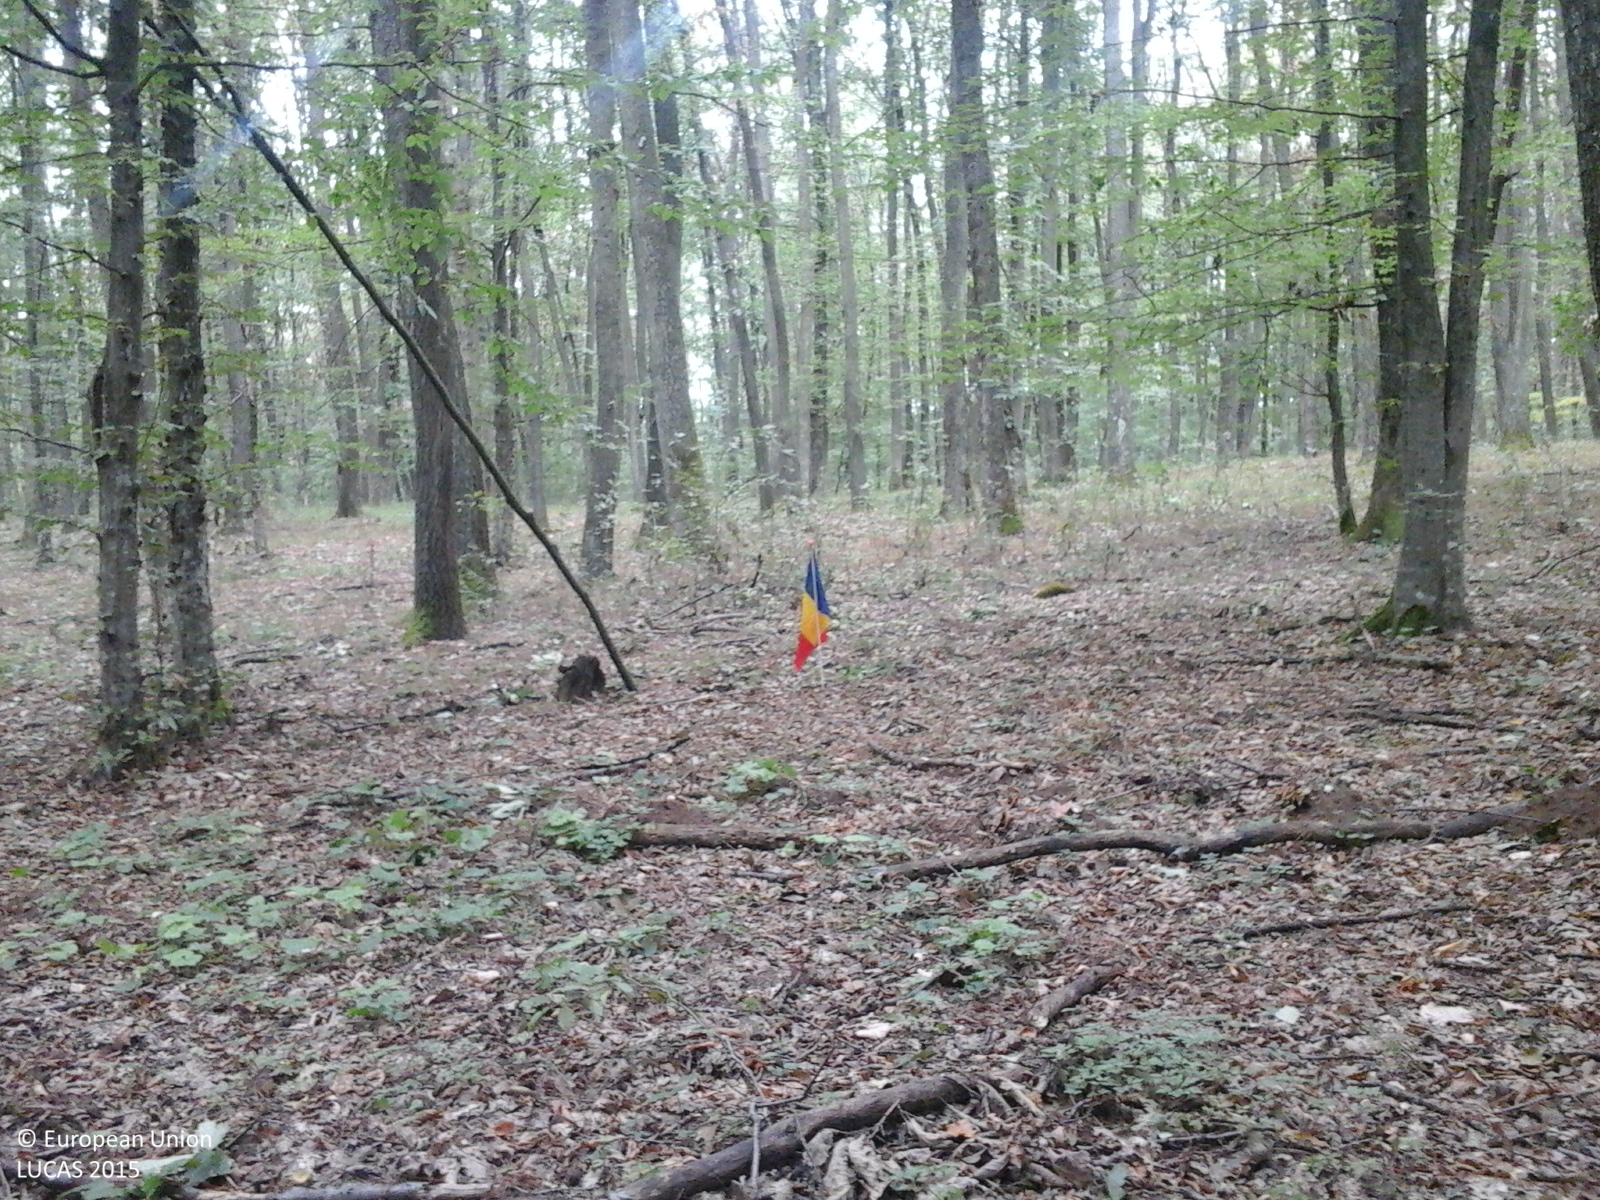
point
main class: Woodland
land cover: Broadleaved woodland
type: acidophilous oak and oak-birch forest
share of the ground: > 75 %
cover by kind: broadleaved forest trees 100 %
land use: Forestry
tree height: > 5 m
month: September
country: RO
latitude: 47.3991
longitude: 22.6596
